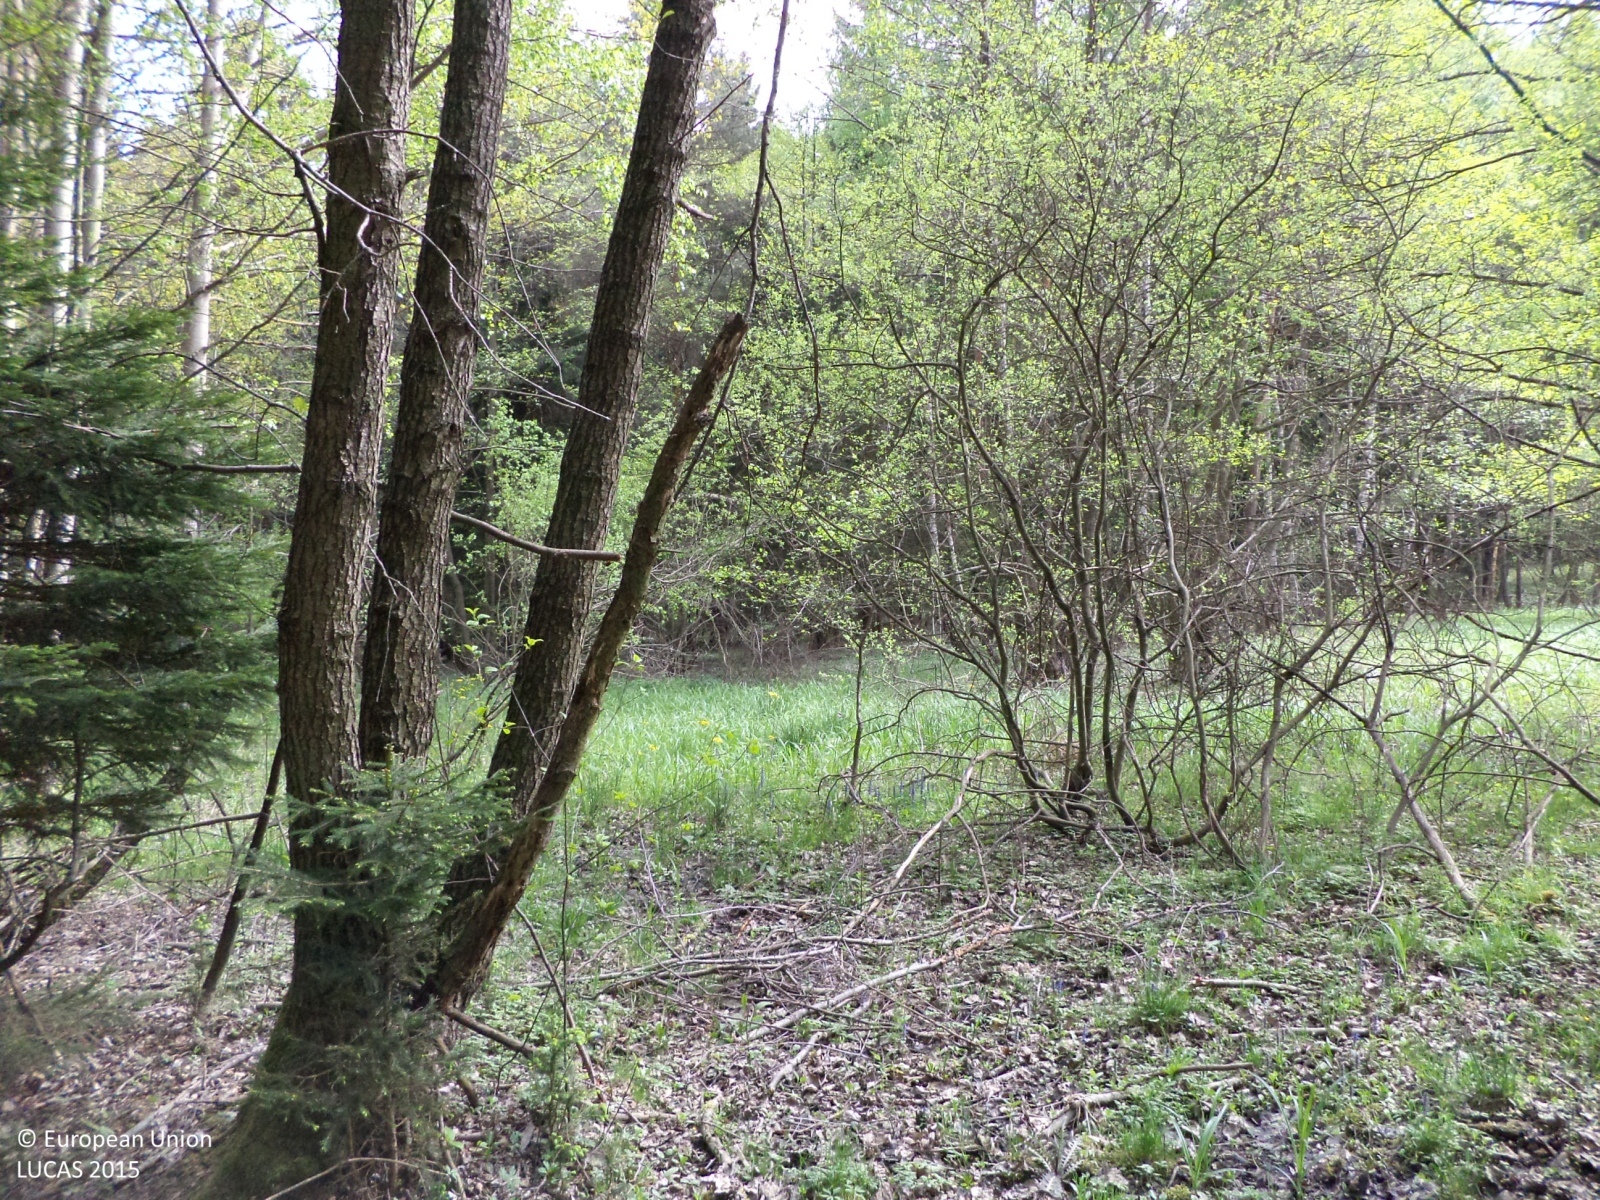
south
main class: Woodland
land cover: Spruce dominated coniferous woodland
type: hemiboreal forest and nemoral coniferous forest and mixed broadleaved-coniferous forest
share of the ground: > 75 %
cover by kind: coniferous forest trees 70 %, broadleaved forest trees 20 %, herbaceous plants 10 %
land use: Forestry
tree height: > 5 m
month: May
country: CZ
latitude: 49.3835
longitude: 15.1409
